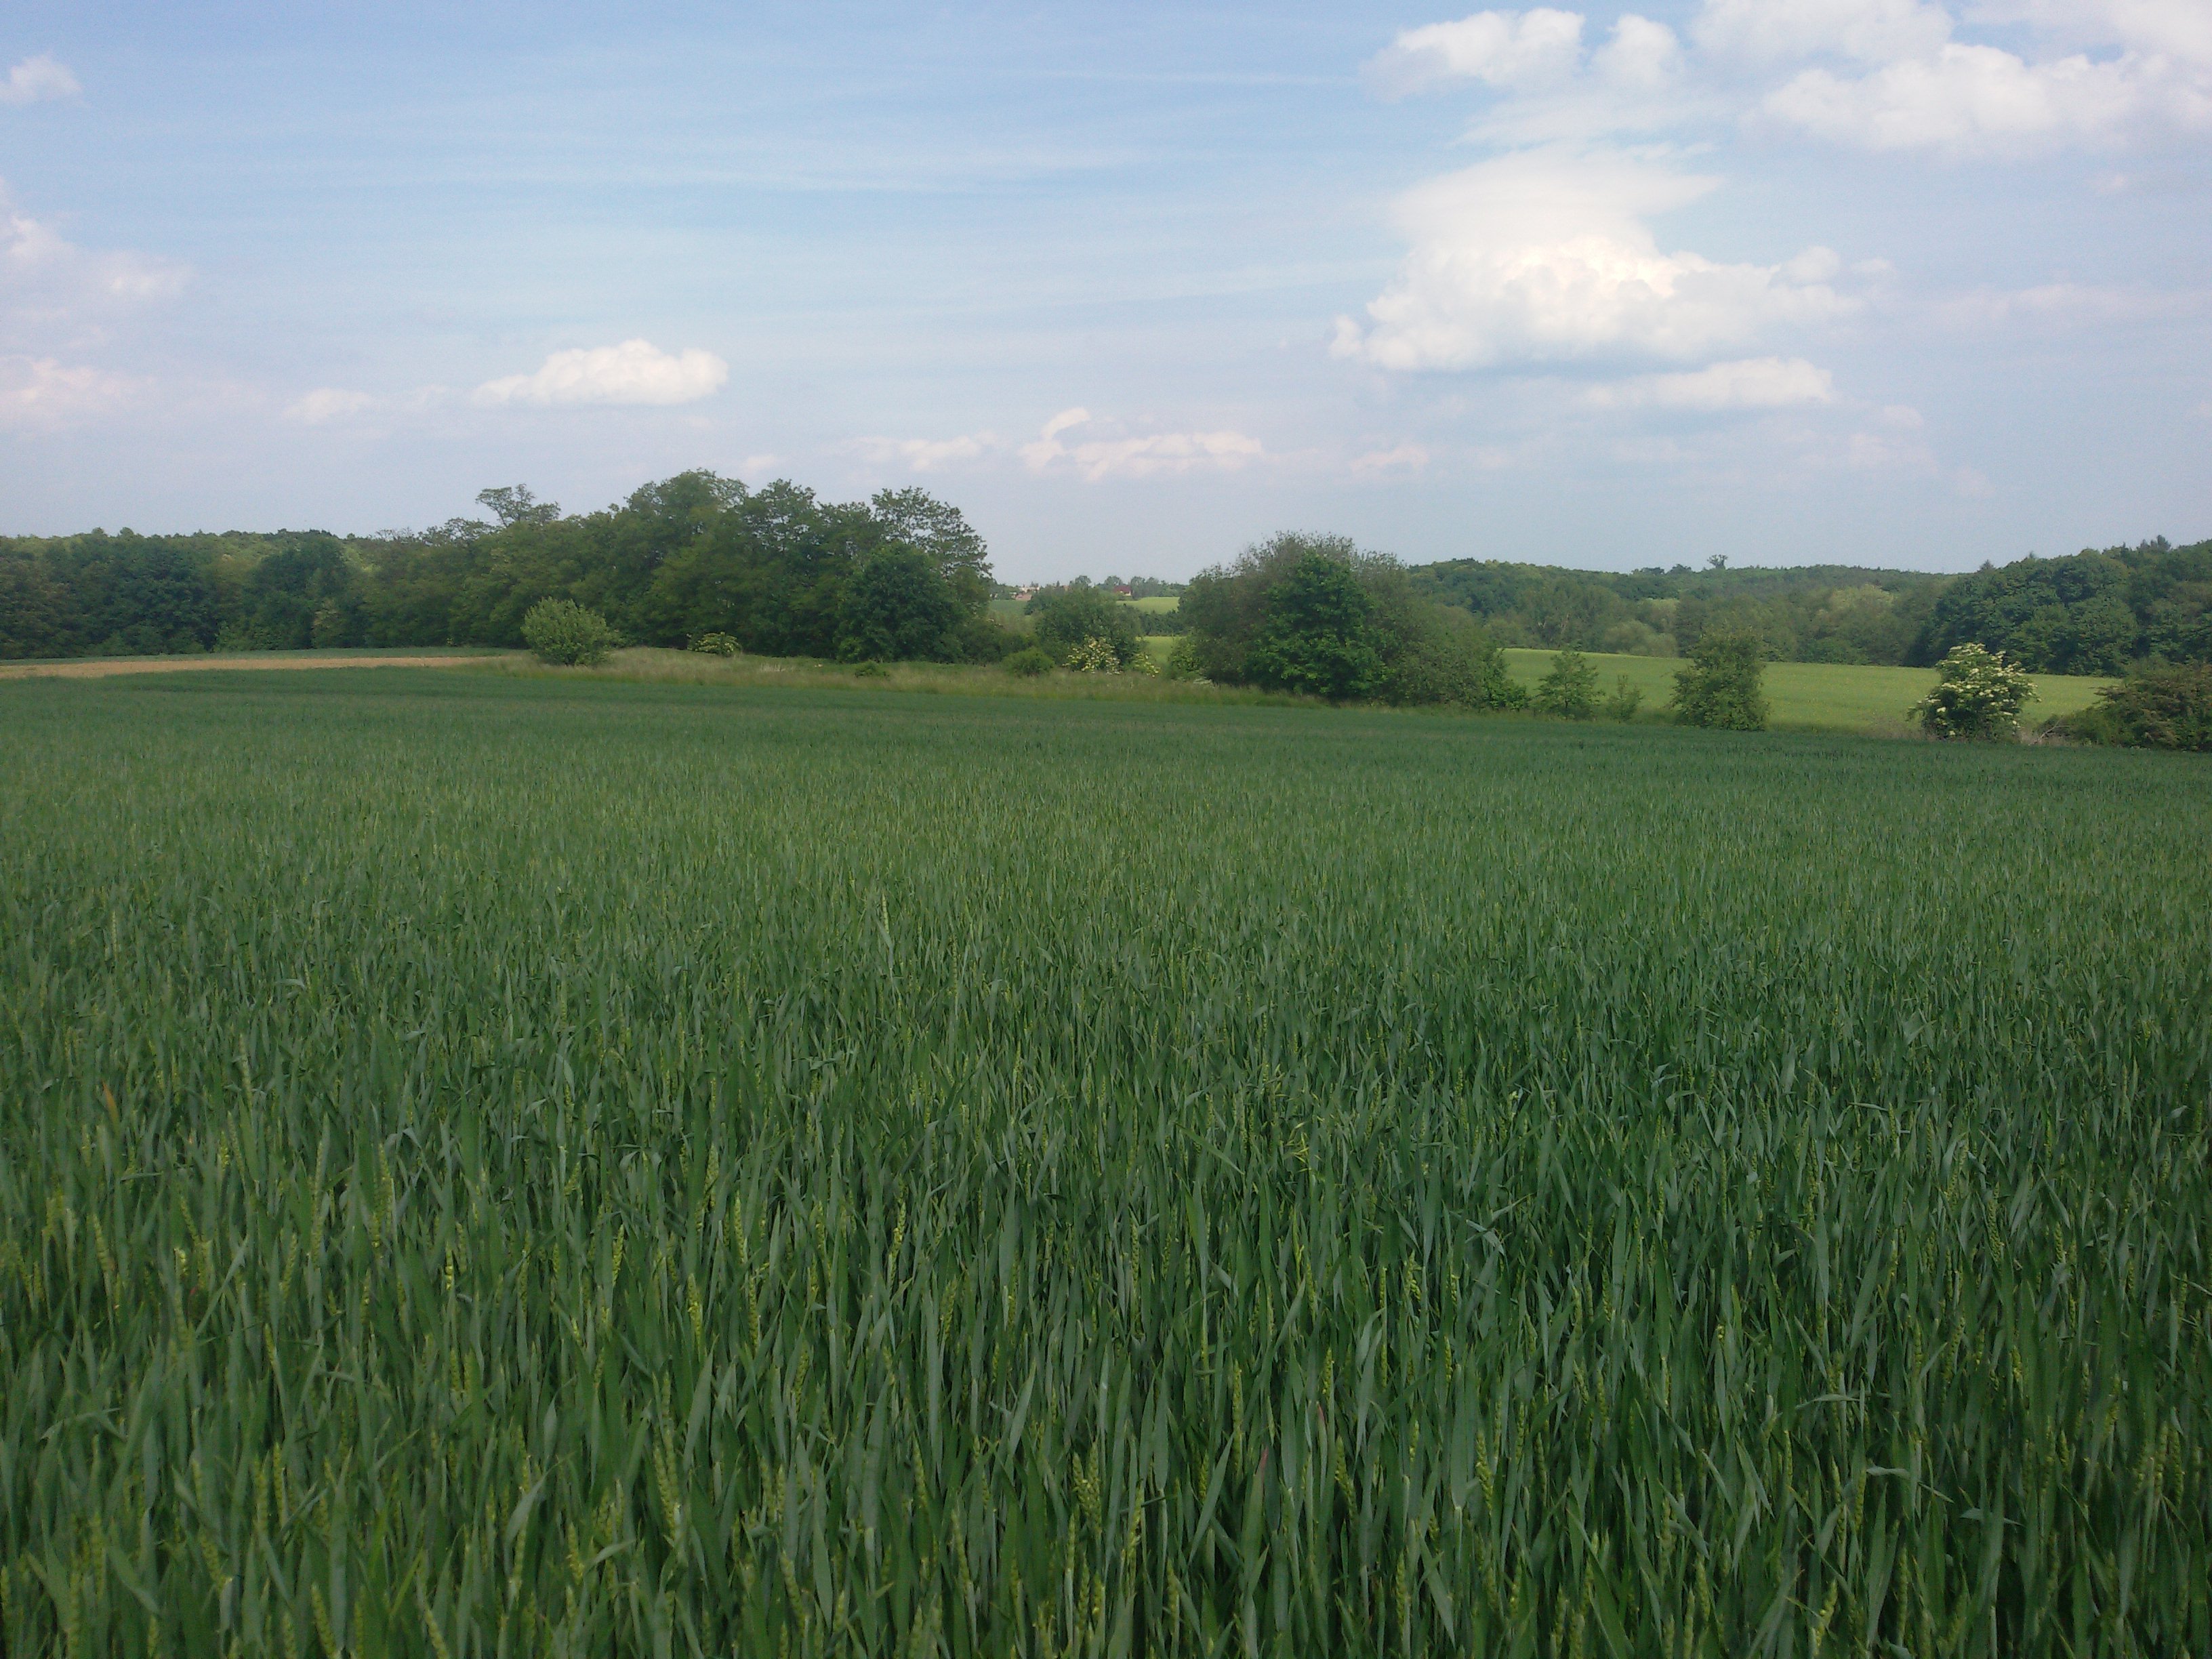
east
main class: Cropland
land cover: Common wheat
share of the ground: > 75 %
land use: Agriculture (excluding fallow land and kitchen gardens)
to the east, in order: Common wheat; Spontaneously vegetated surfaces; Rape and turnip rape
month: May
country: PL
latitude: 50.5347
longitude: 17.1923
